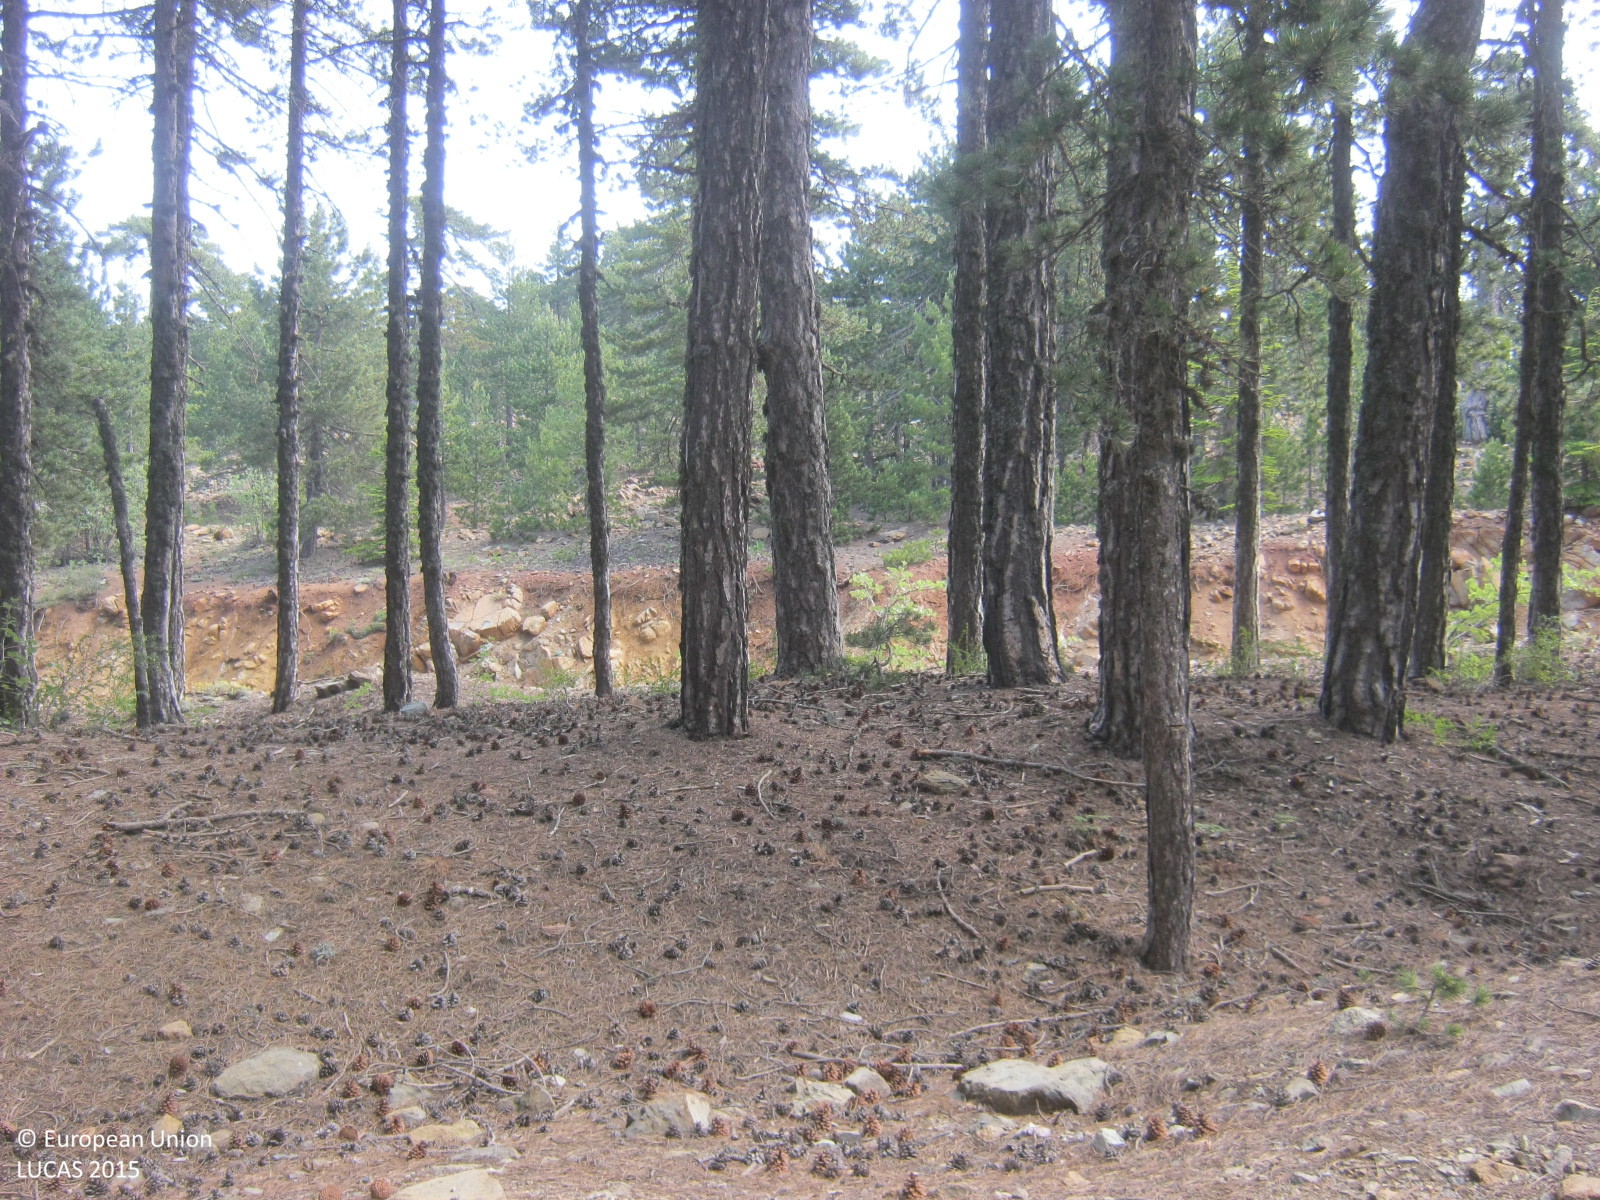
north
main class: Woodland
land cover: Pine dominated coniferous woodland
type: coniferous forest of the mediterranean region
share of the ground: > 75 %
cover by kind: coniferous forest trees 80 %, unconsolidated bare surface 15 %, shrubs 5 %
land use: Forestry
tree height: > 5 m
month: June
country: CY
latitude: 34.9412
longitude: 32.8638
